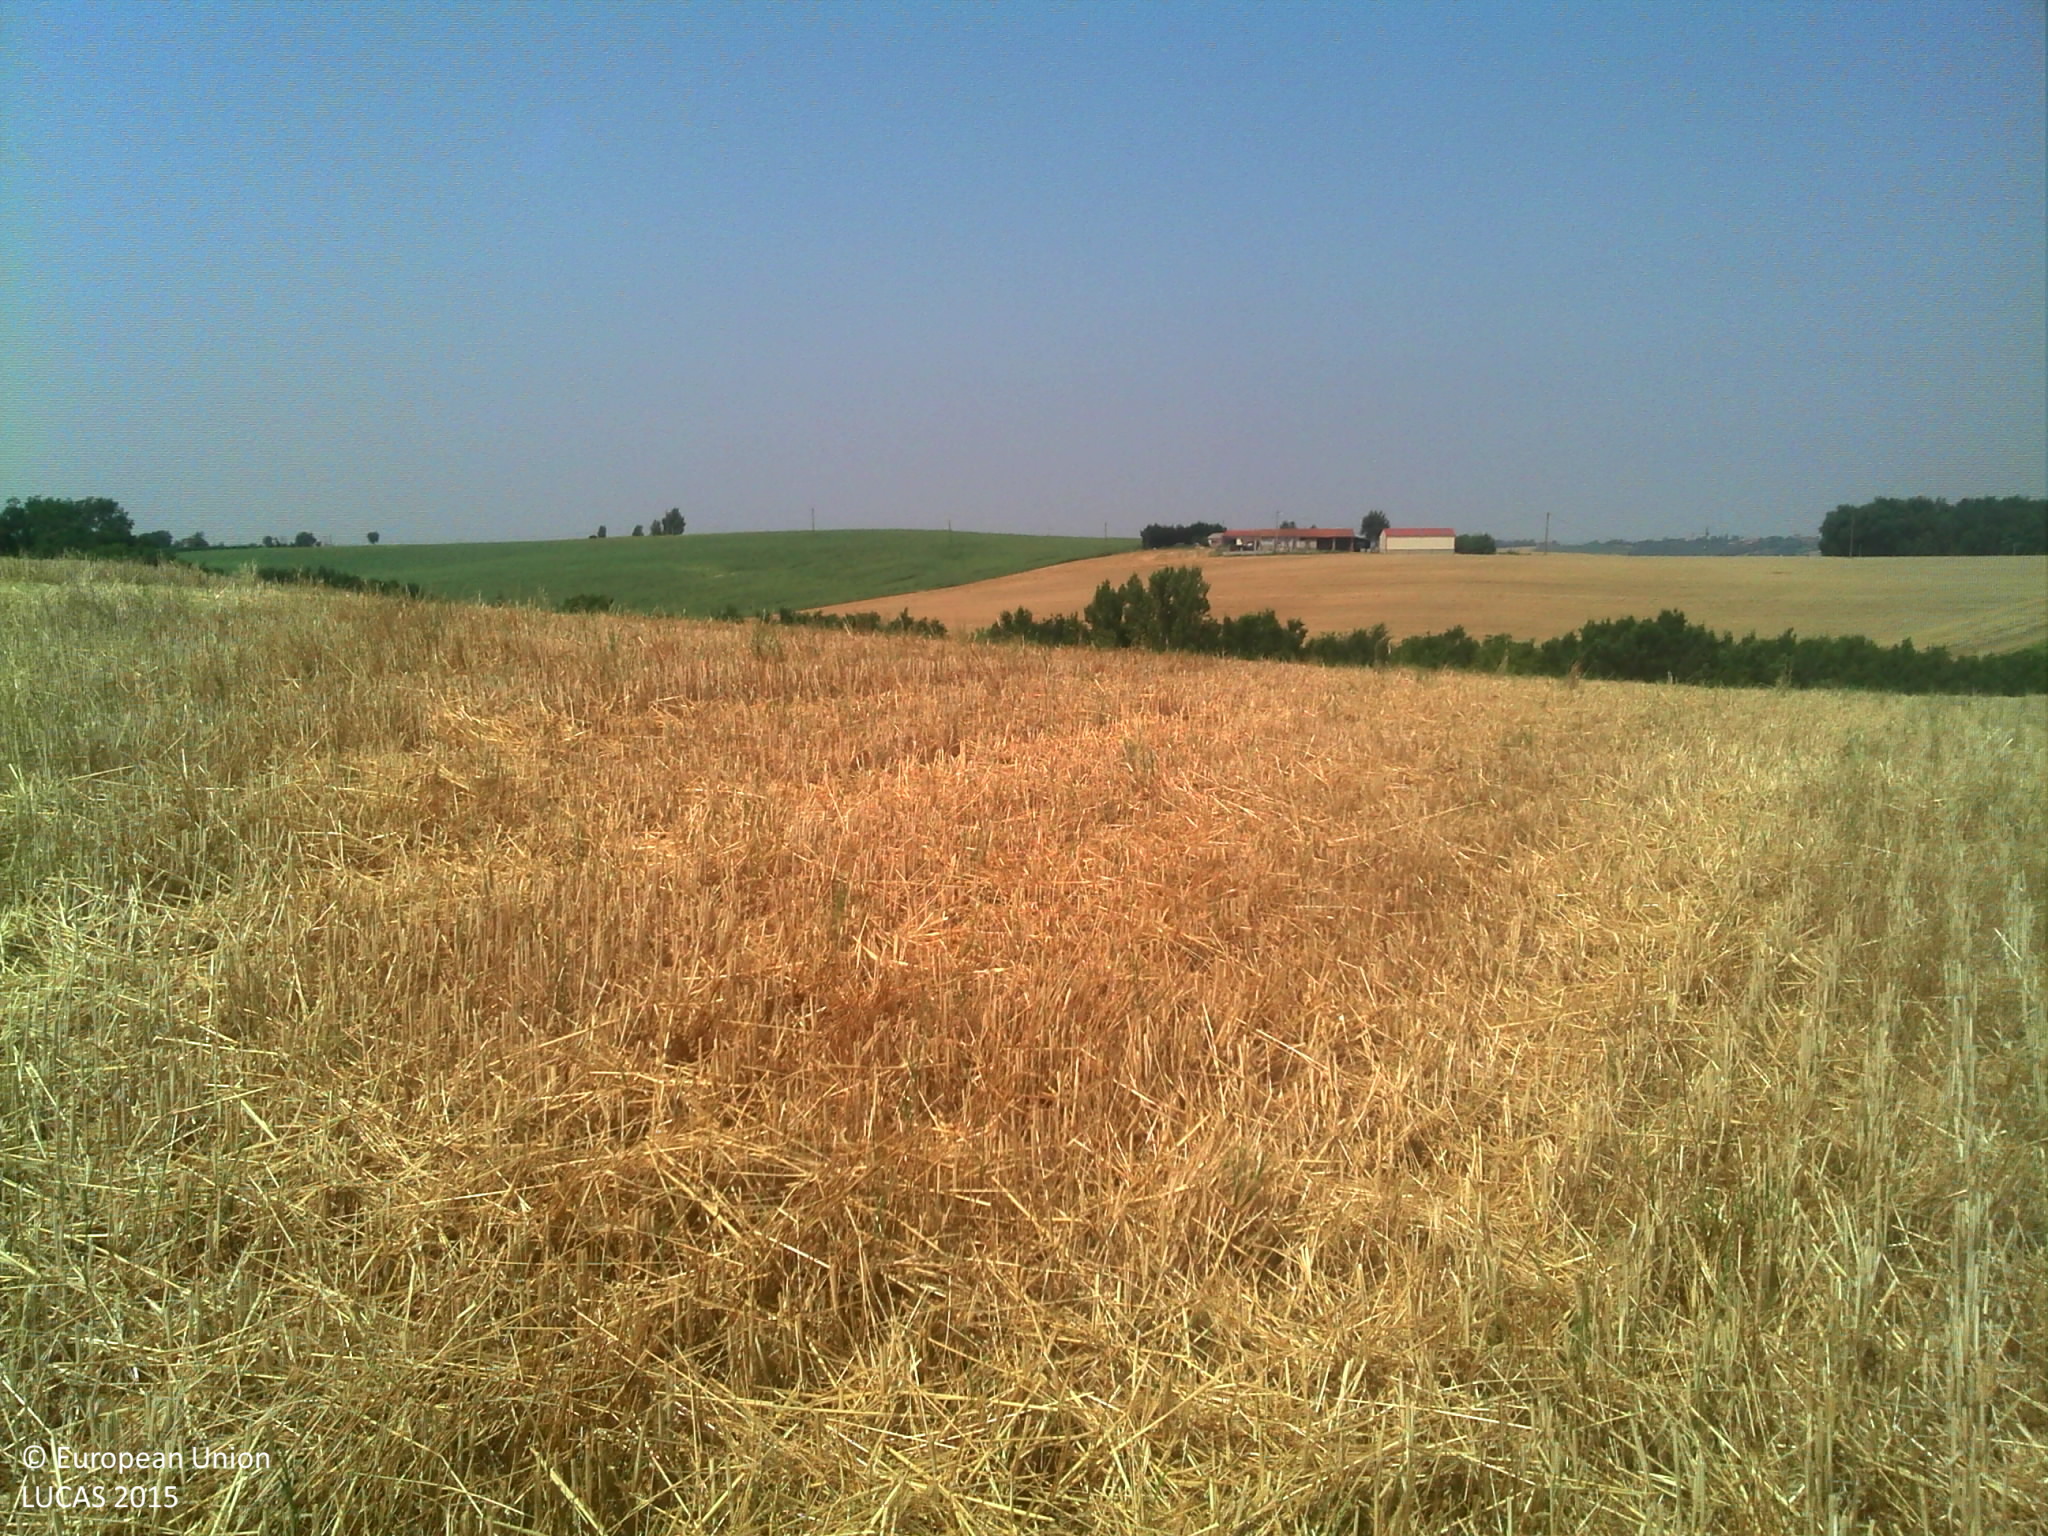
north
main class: Cropland
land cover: Triticale
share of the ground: > 75 %
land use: Agriculture (excluding fallow land and kitchen gardens)
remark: Harvested field
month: July
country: FR
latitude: 43.3032
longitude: 1.6099
